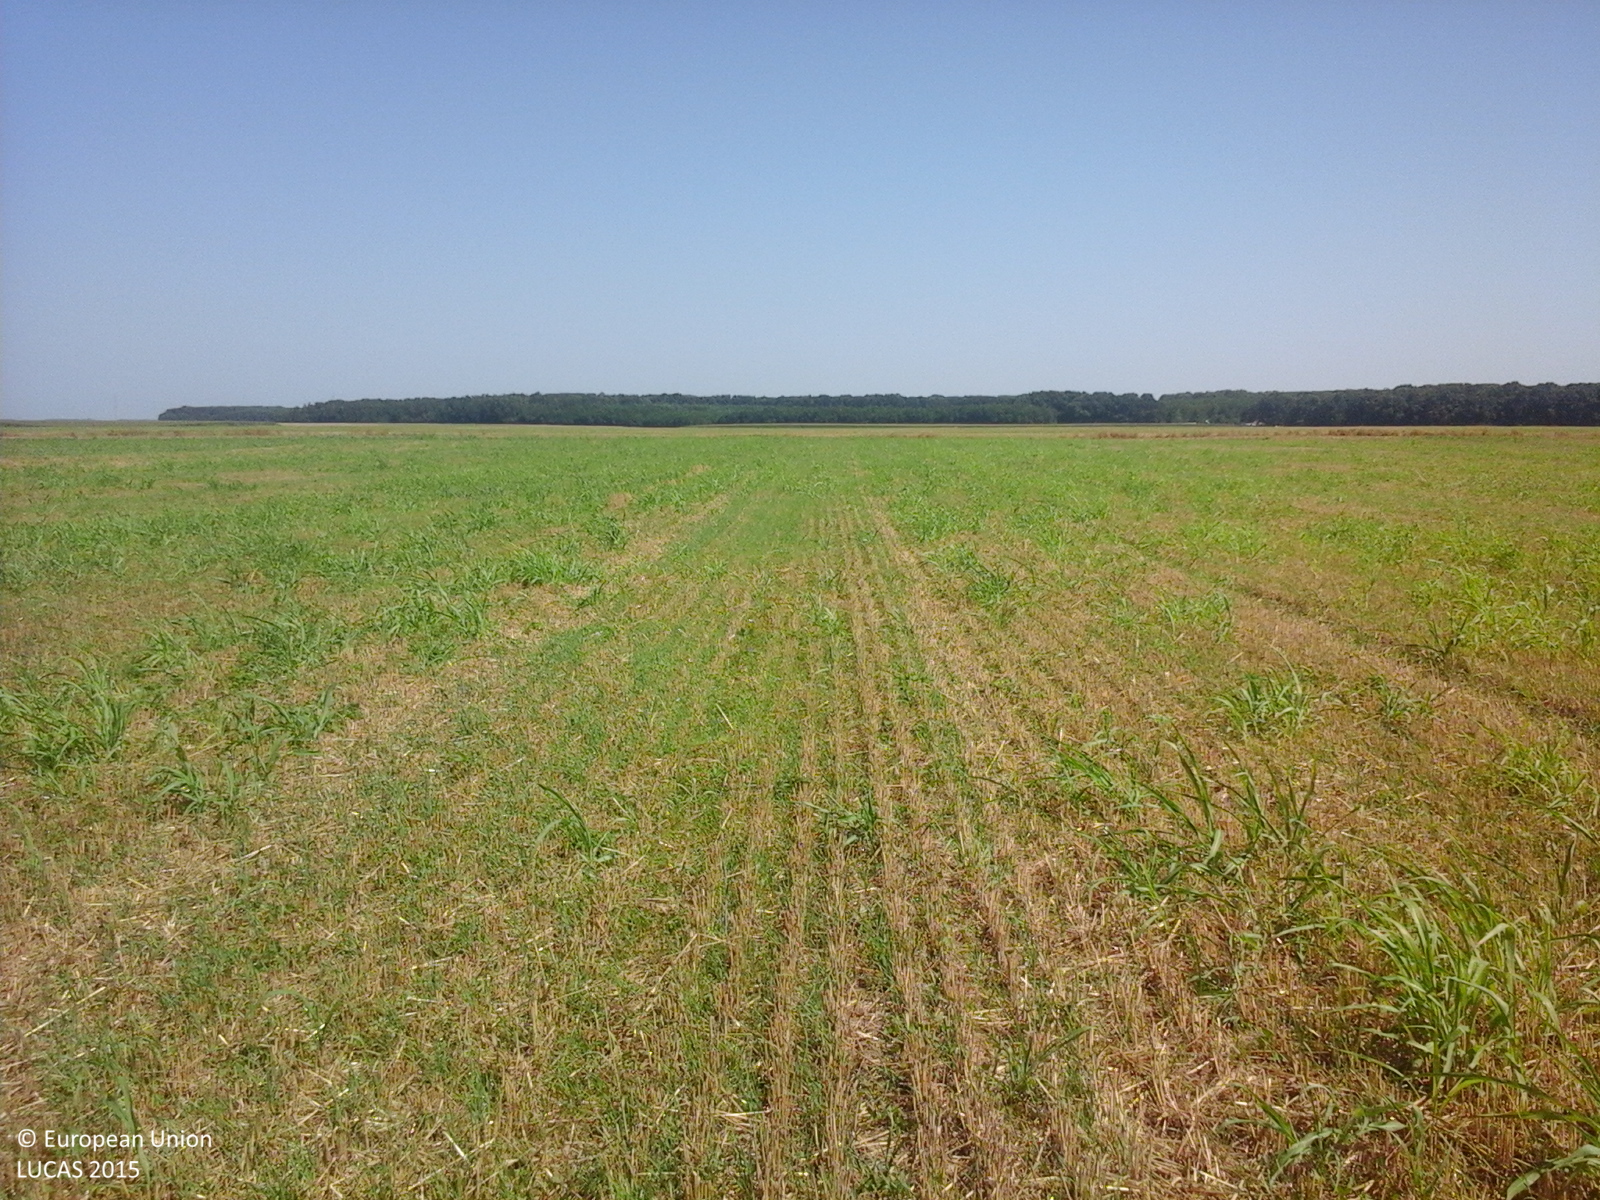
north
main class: Cropland
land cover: Common wheat
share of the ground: 50 - 75 %
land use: Agriculture (excluding fallow land and kitchen gardens)
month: July
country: RO
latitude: 44.3797
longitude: 26.4935
